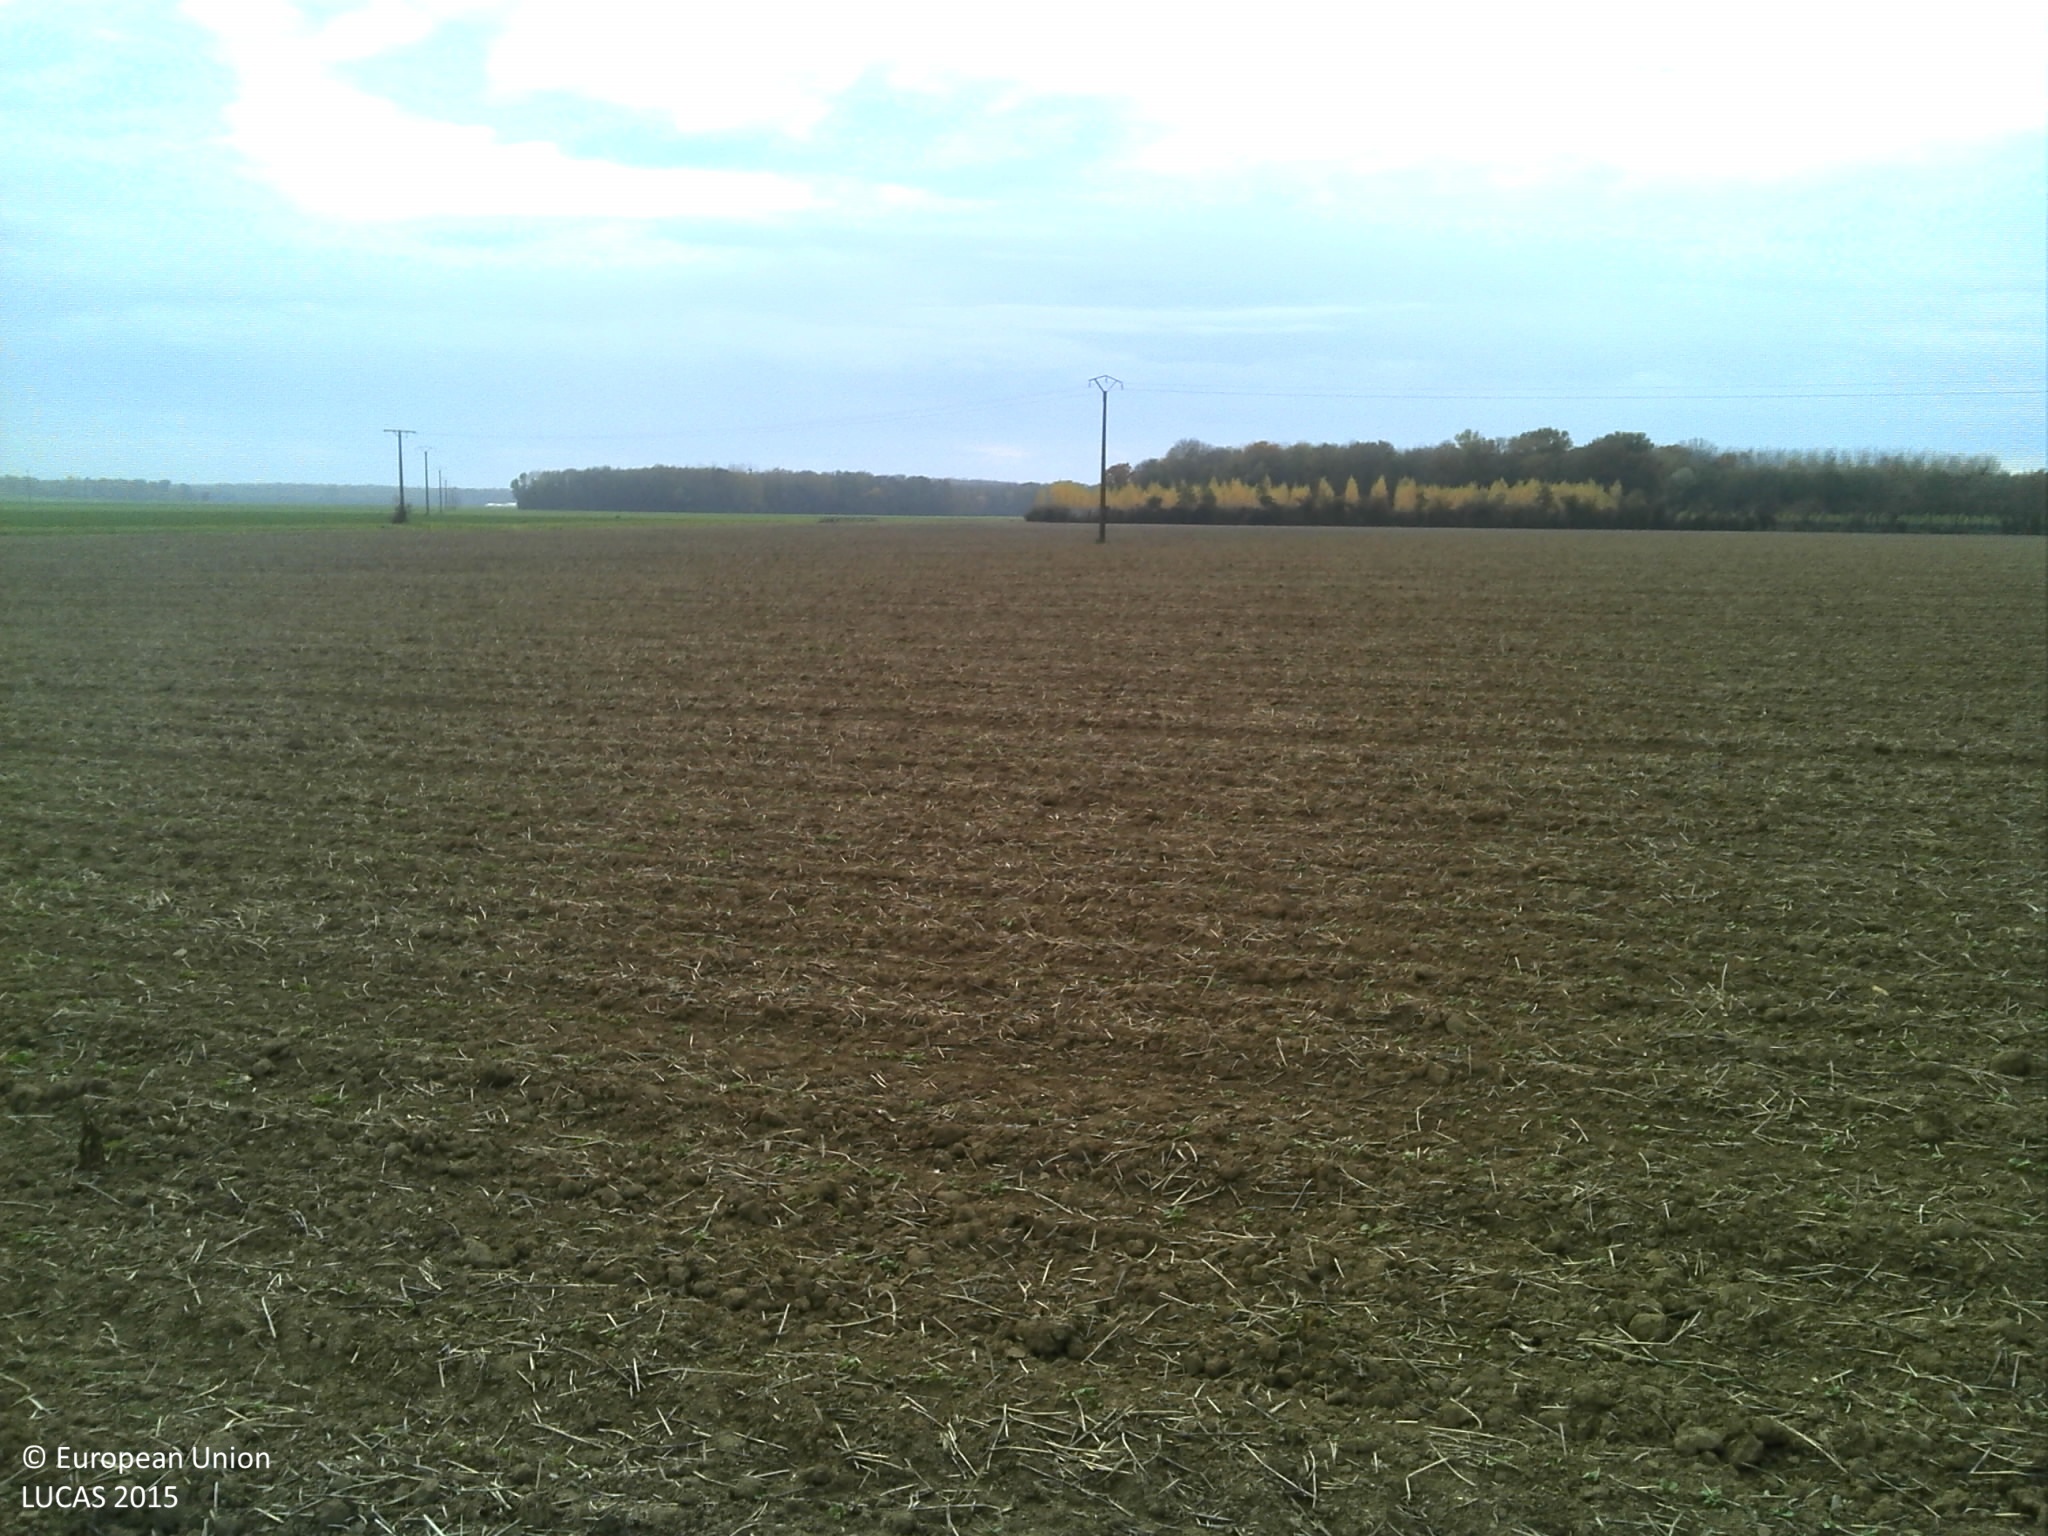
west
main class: Cropland
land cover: Other fibre and oleaginous crops
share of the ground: < 10 %
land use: Agriculture (excluding fallow land and kitchen gardens)
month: October
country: FR
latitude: 47.0585
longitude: 5.2749
